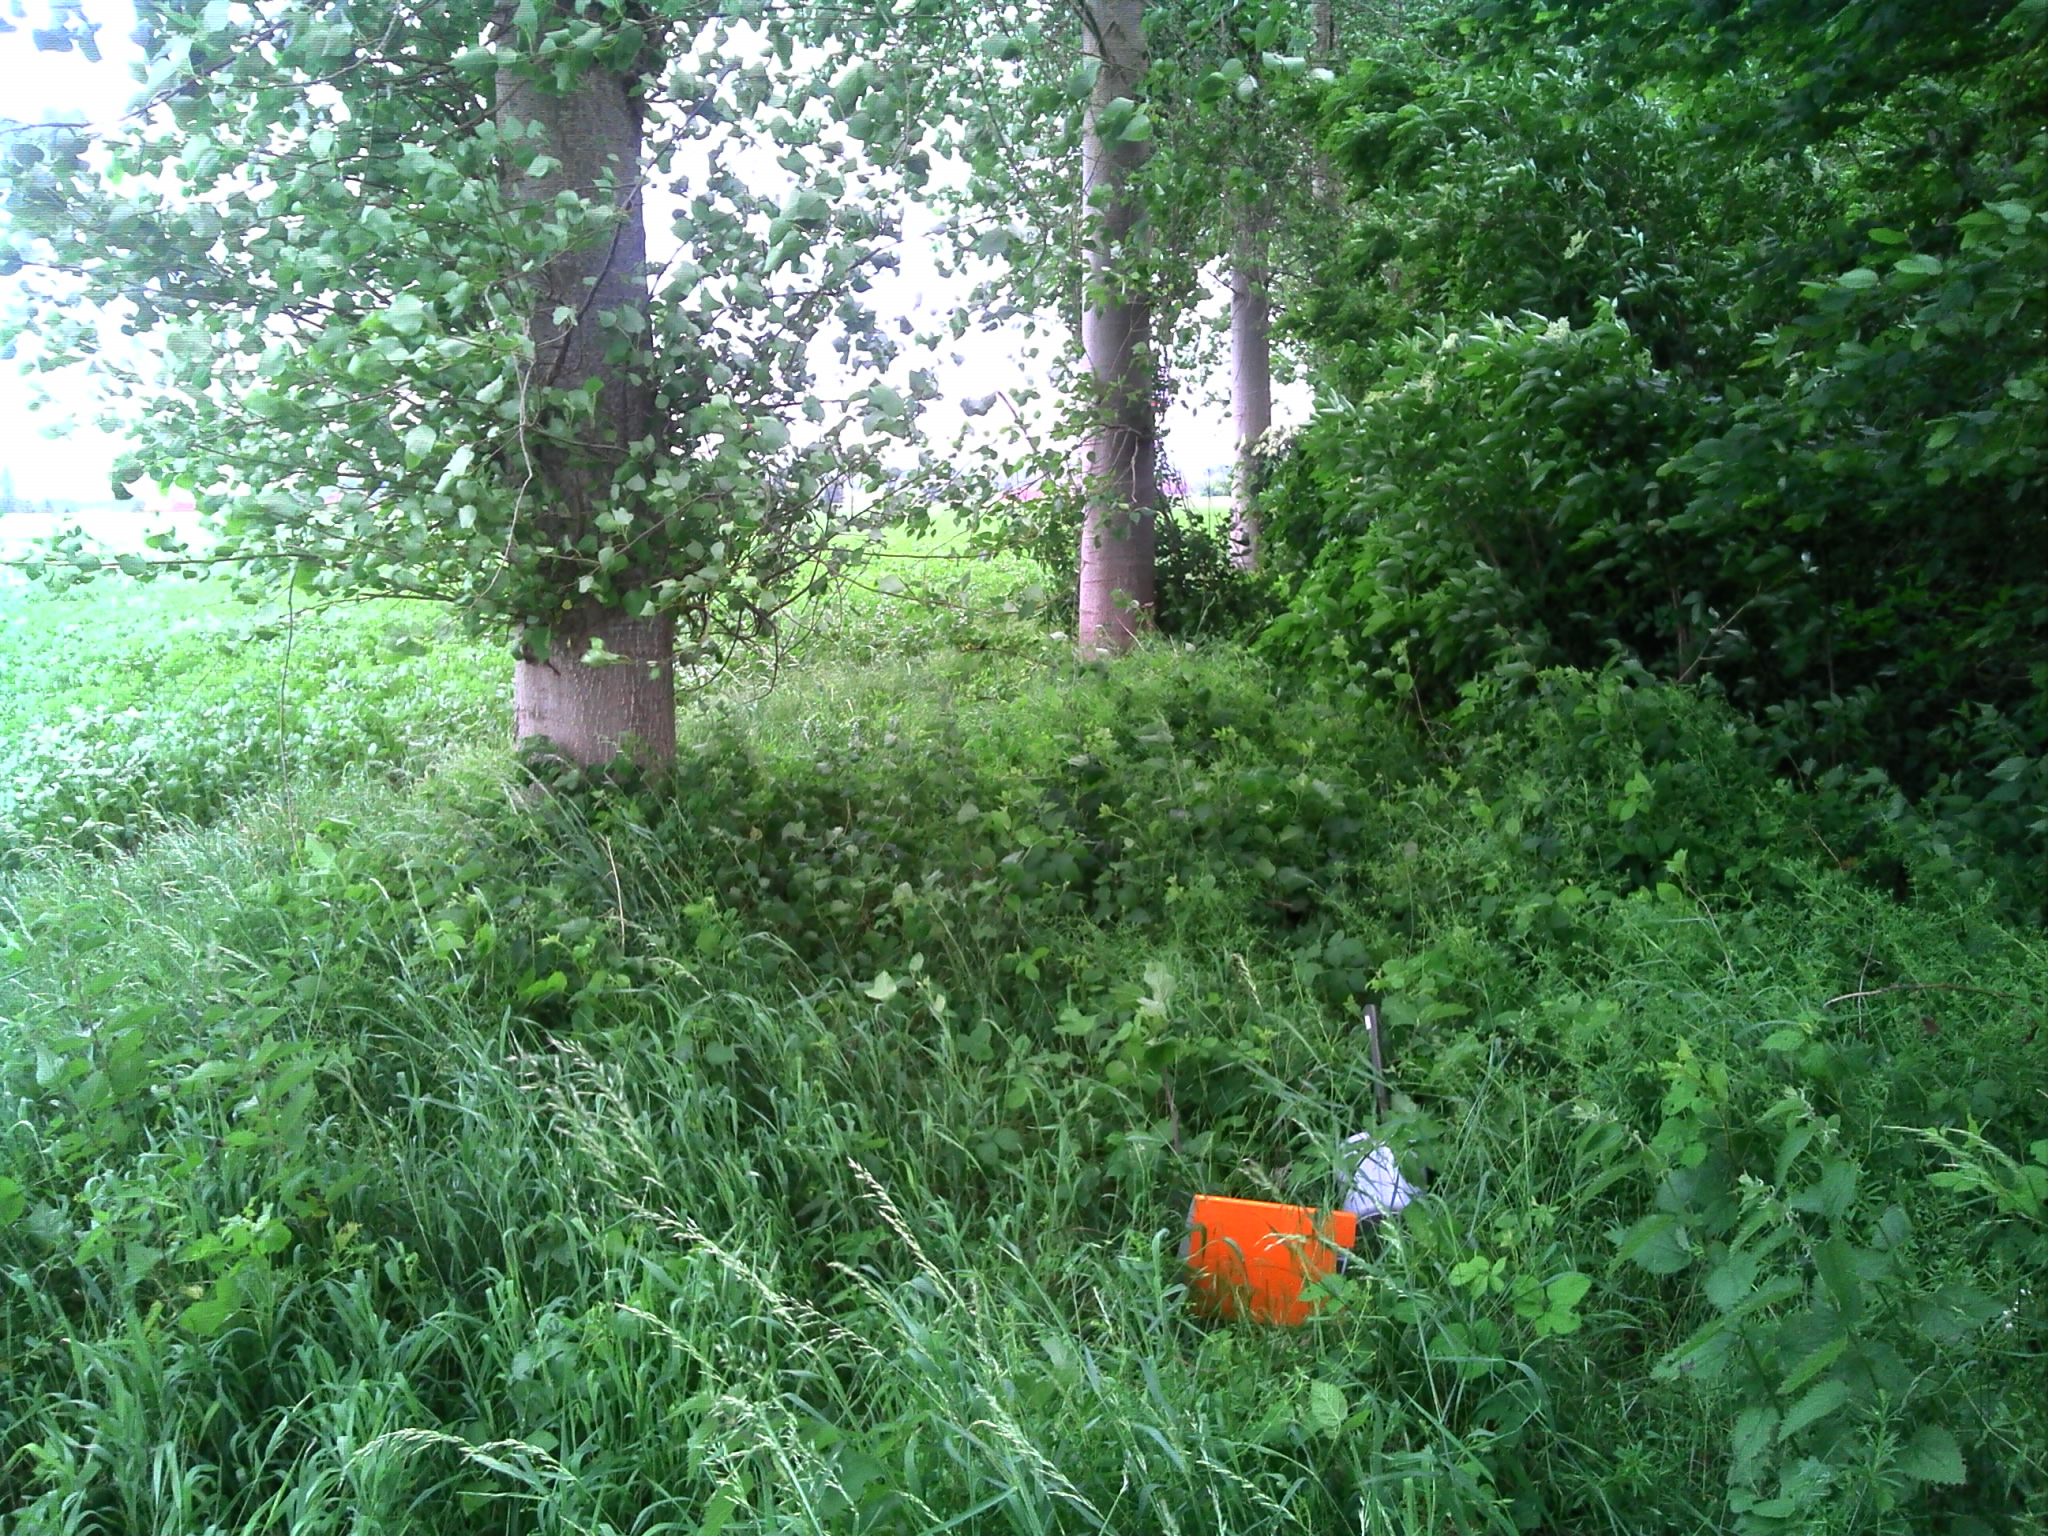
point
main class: Woodland
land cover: Broadleaved woodland
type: exotic forest
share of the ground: > 75 %
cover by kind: broadleaved forest trees 90 %, shrubs 10 %
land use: Forestry
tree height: > 5 m
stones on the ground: < 10 %
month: June
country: FR
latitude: 49.5858
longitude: 3.2276
